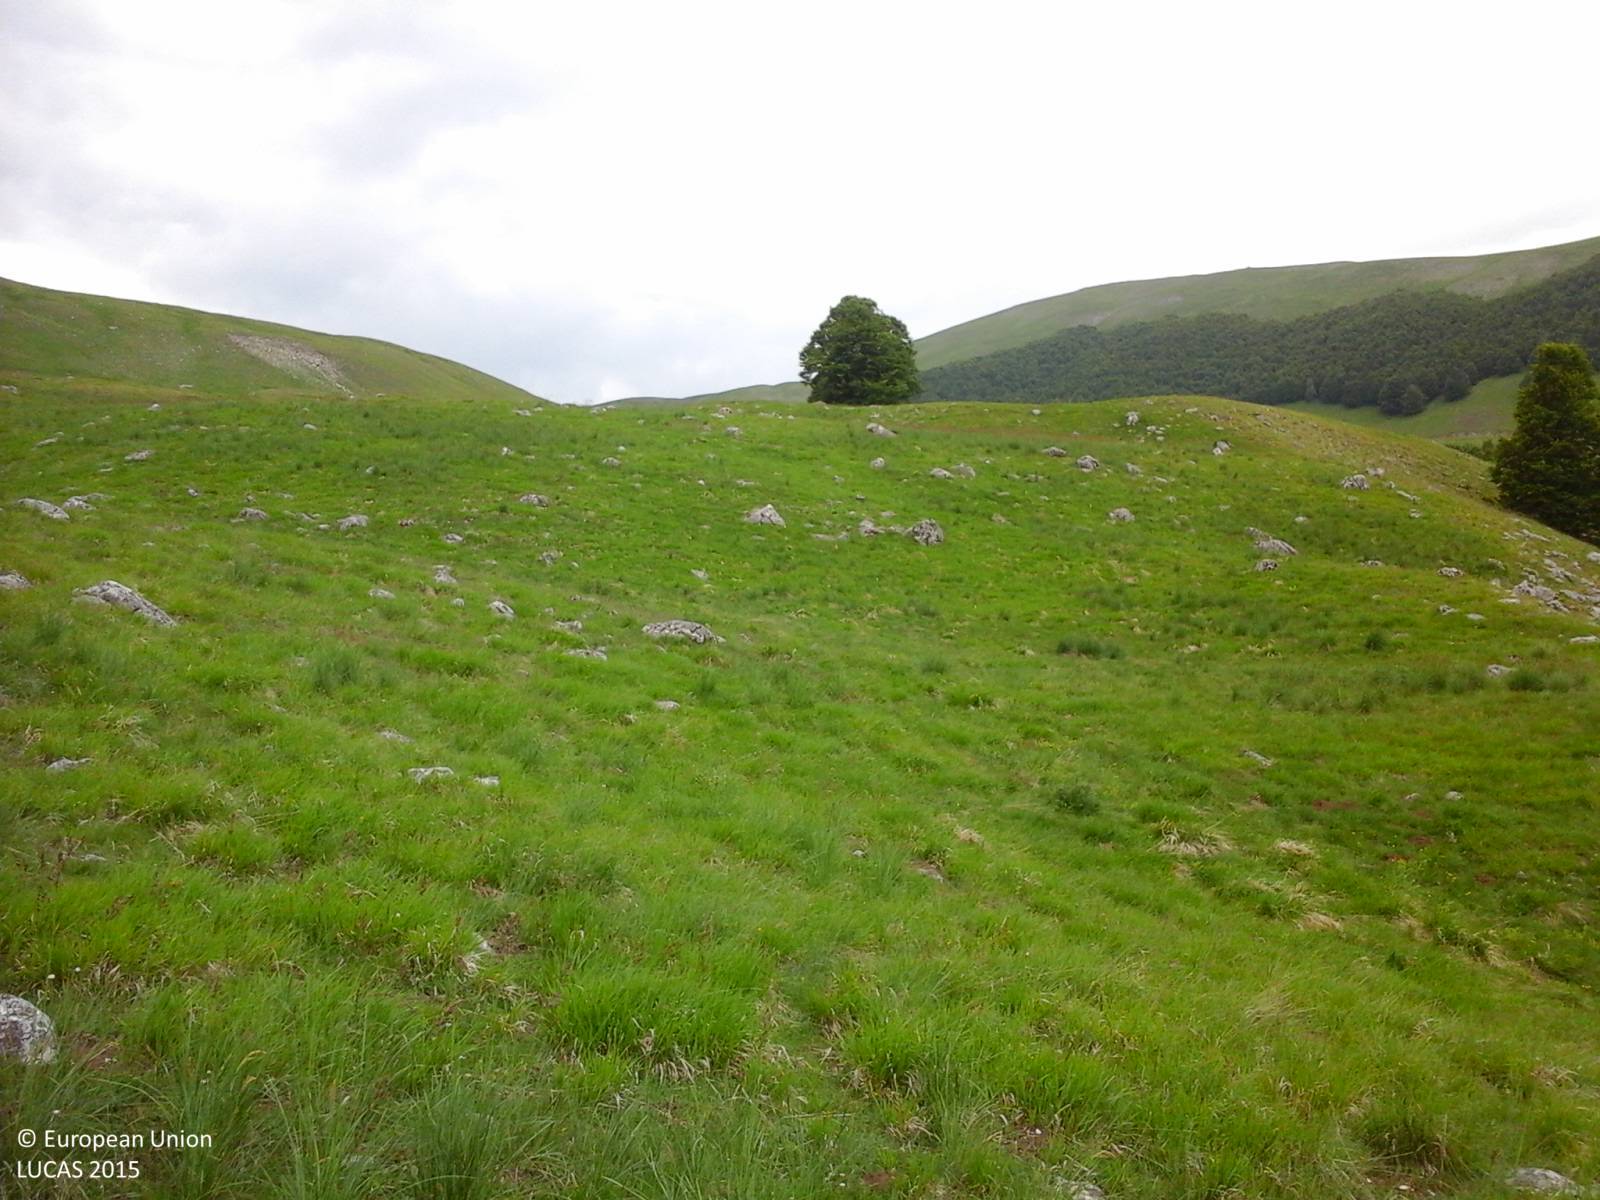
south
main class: Grassland
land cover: Grassland without tree/shrub cover
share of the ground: > 75 %
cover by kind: herbaceous plants 95 %, unconsolidated bare surface 5 %
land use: Agriculture (excluding fallow land and kitchen gardens)
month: June
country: IT
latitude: 41.8526
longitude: 13.9732
